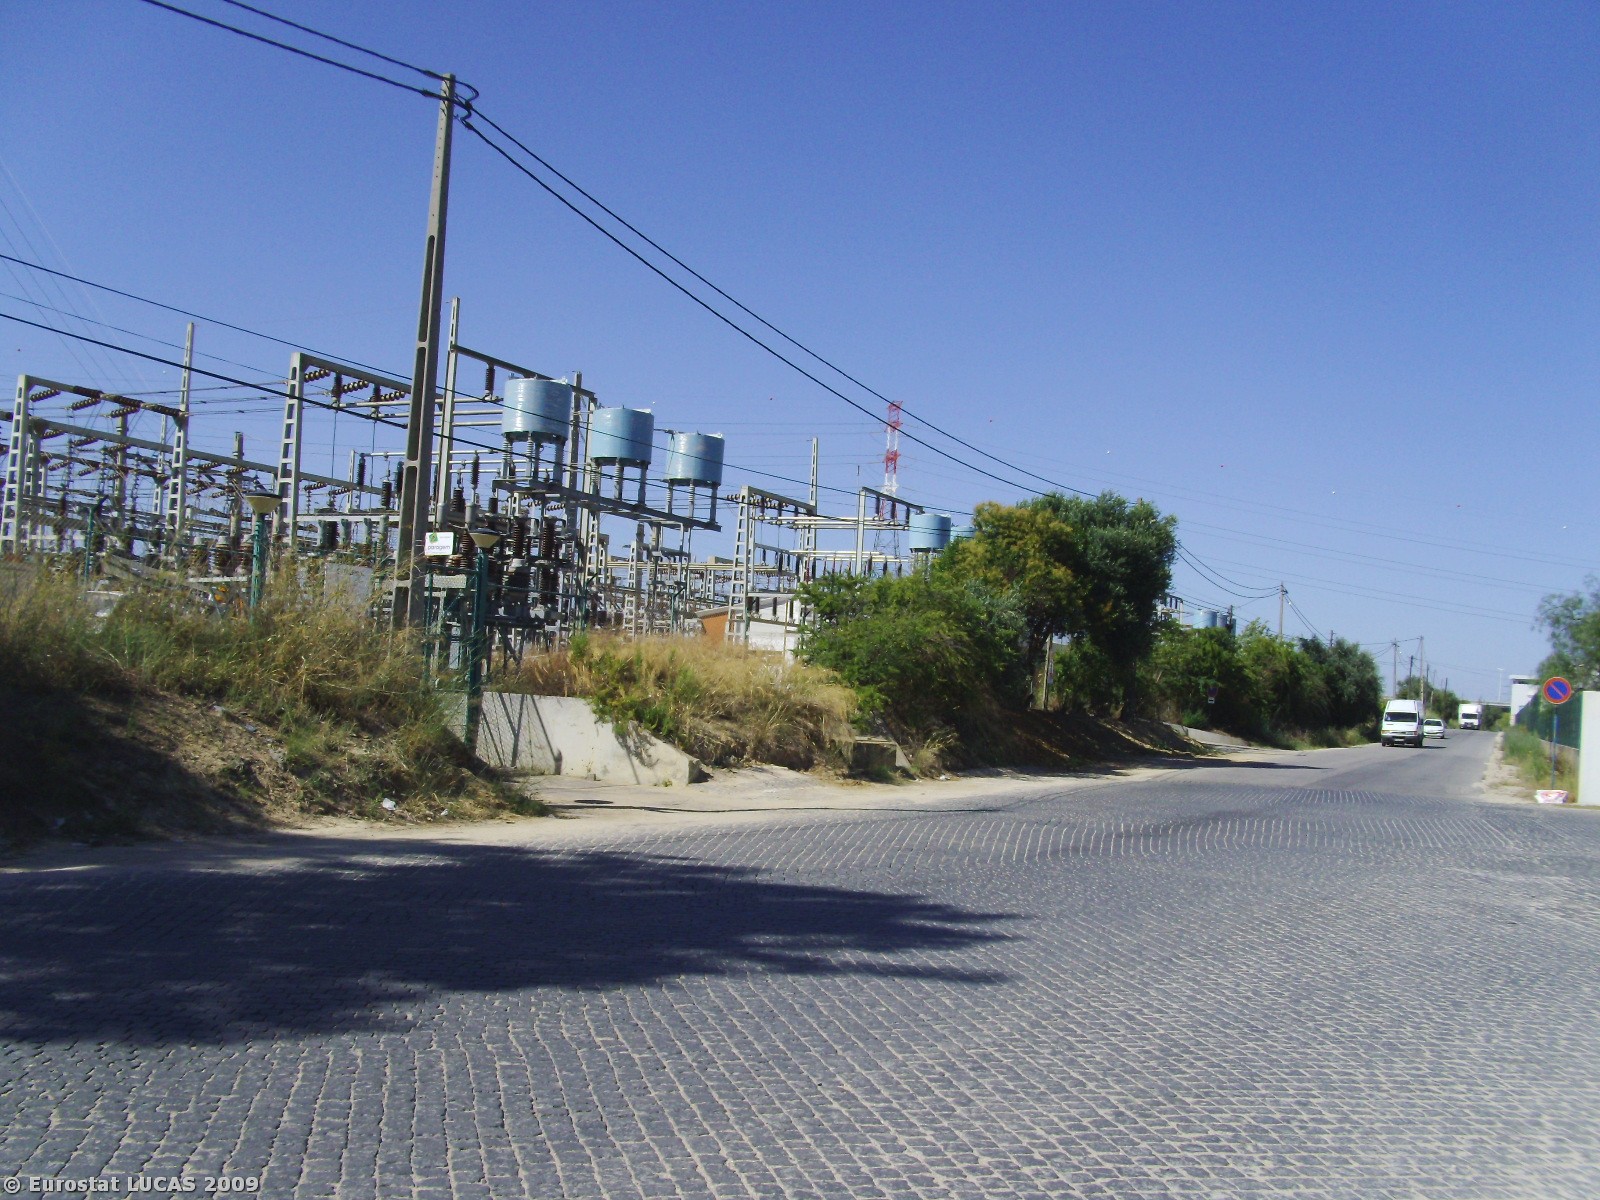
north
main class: Grassland
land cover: Spontaneously vegetated surfaces
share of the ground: > 75 %
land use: Fallow land
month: July
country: PT
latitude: 39.0111
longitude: -8.9576
